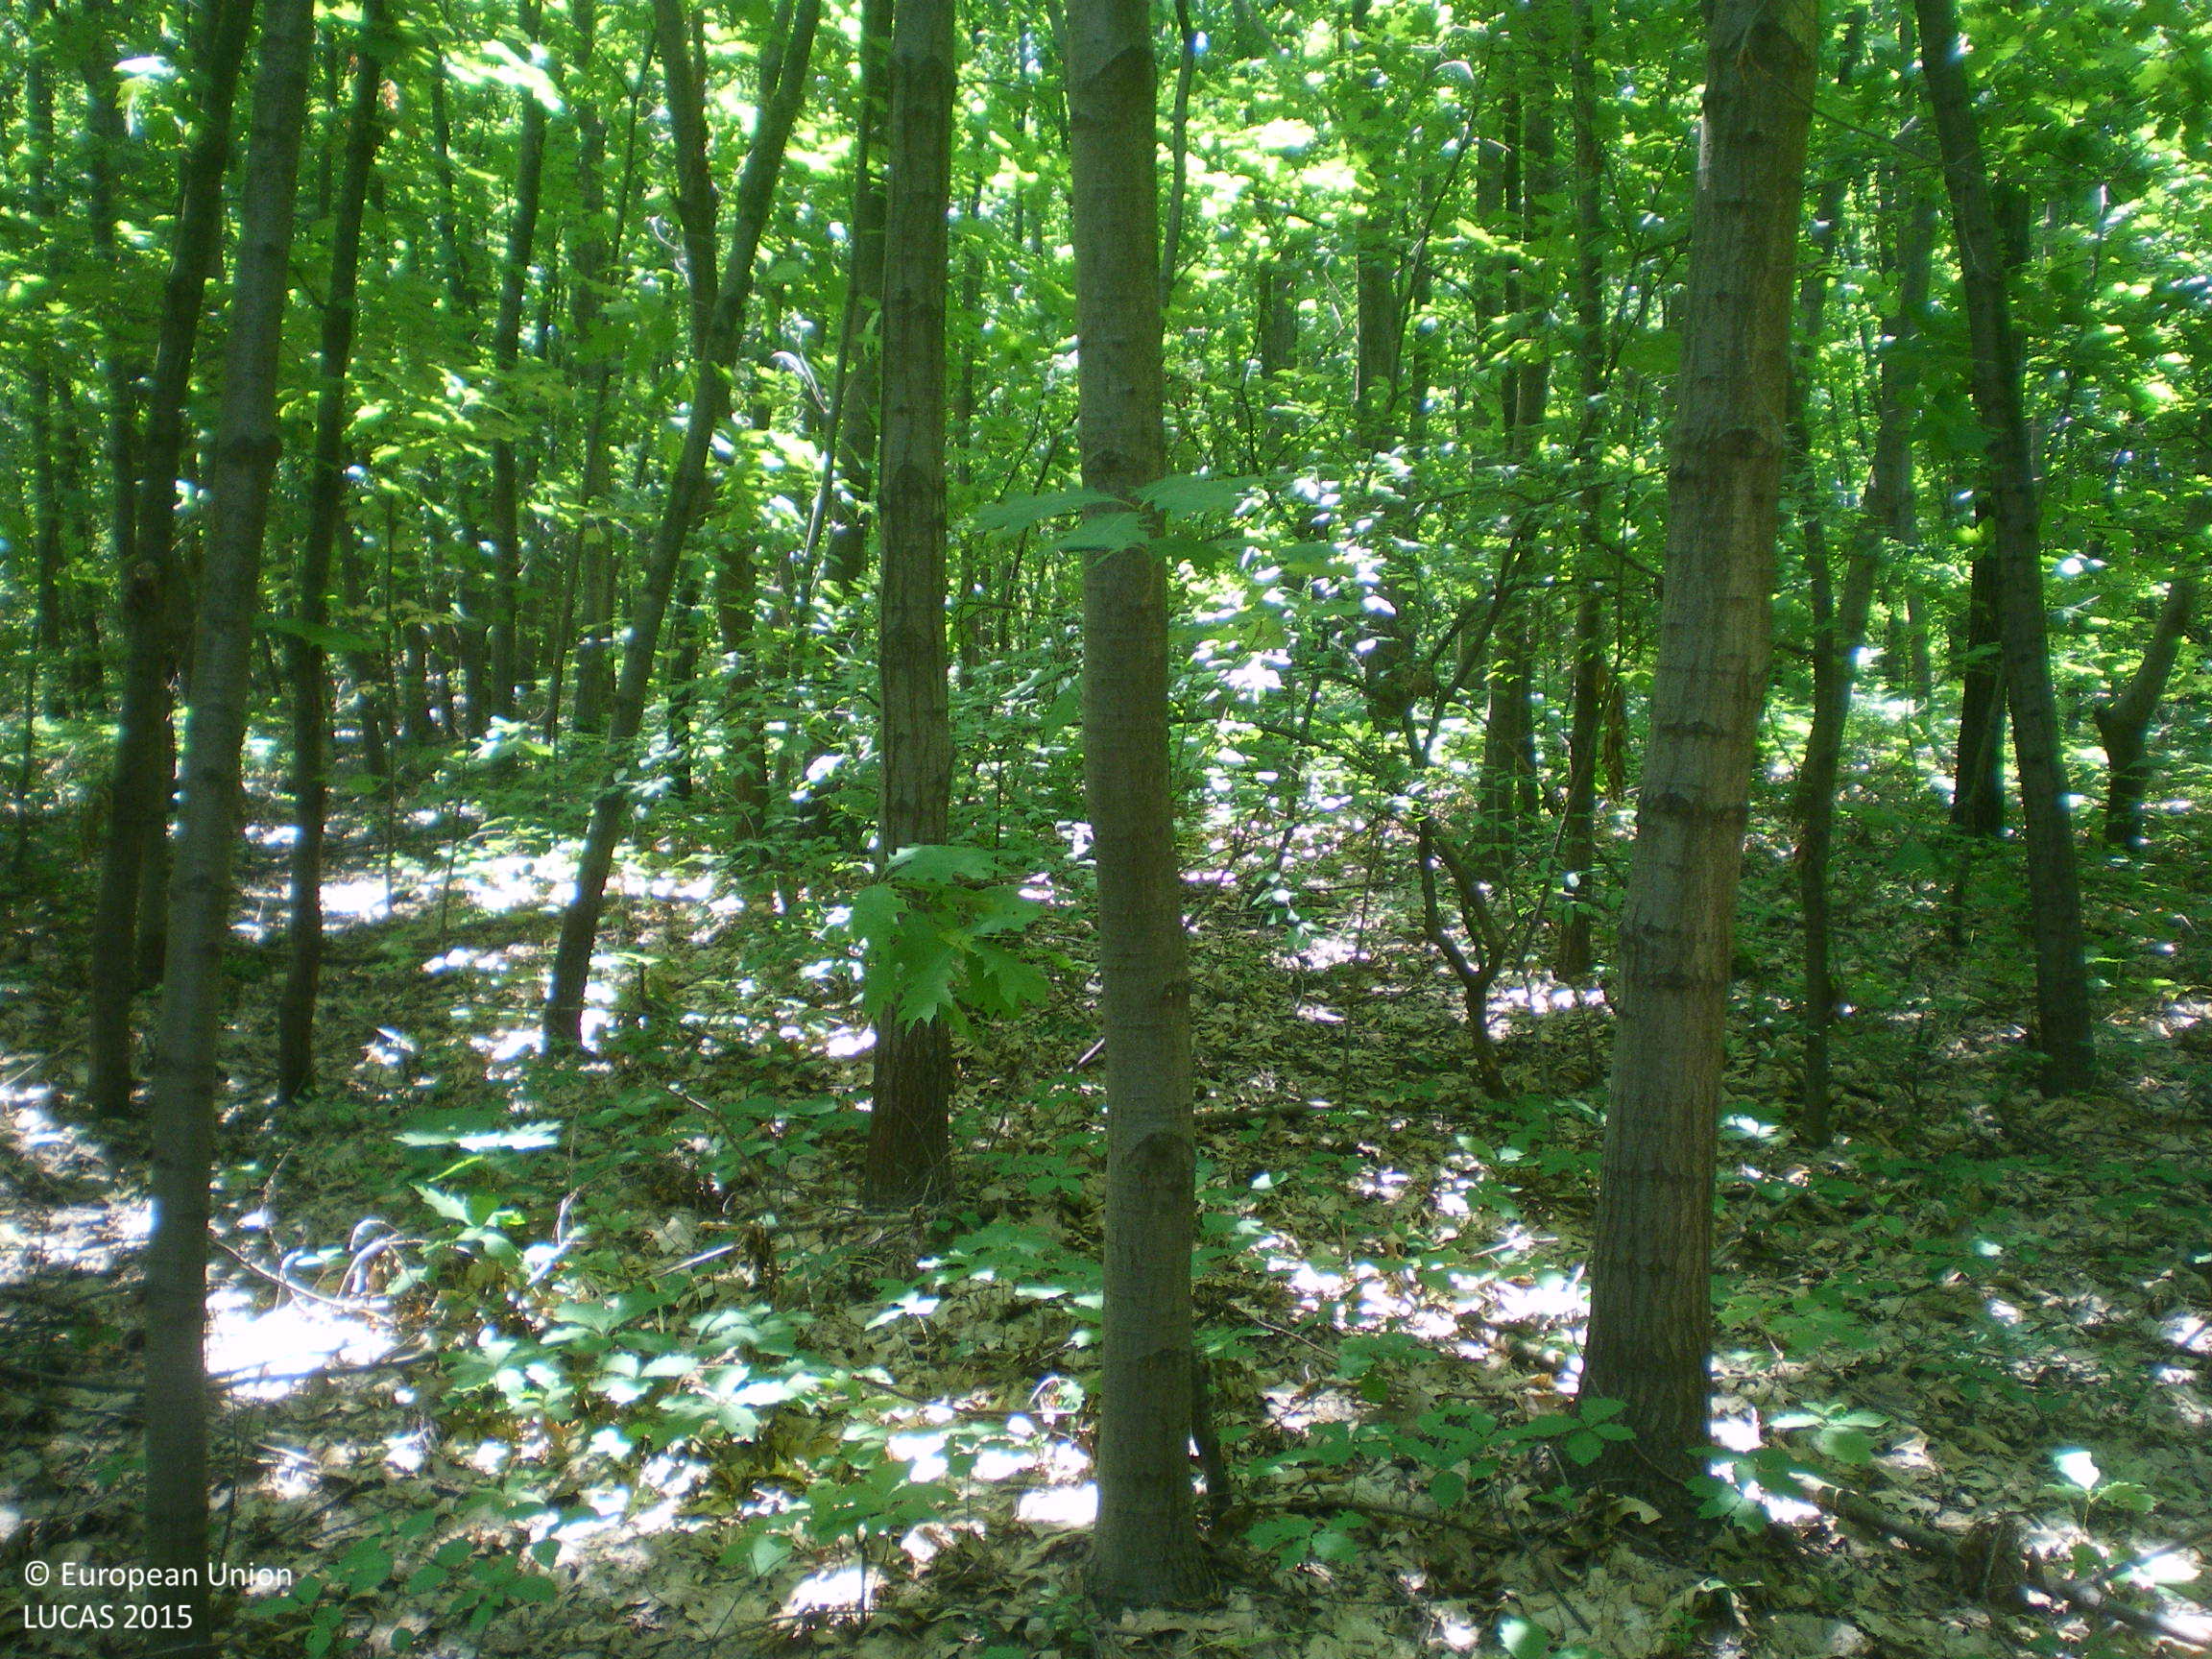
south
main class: Woodland
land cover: Broadleaved woodland
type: mesophytic deciduous forest
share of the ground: > 75 %
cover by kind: broadleaved forest trees 95 %, herbaceous plants 5 %
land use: Forestry
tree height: > 5 m
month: June
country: BG
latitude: 42.2268
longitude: 25.1194
